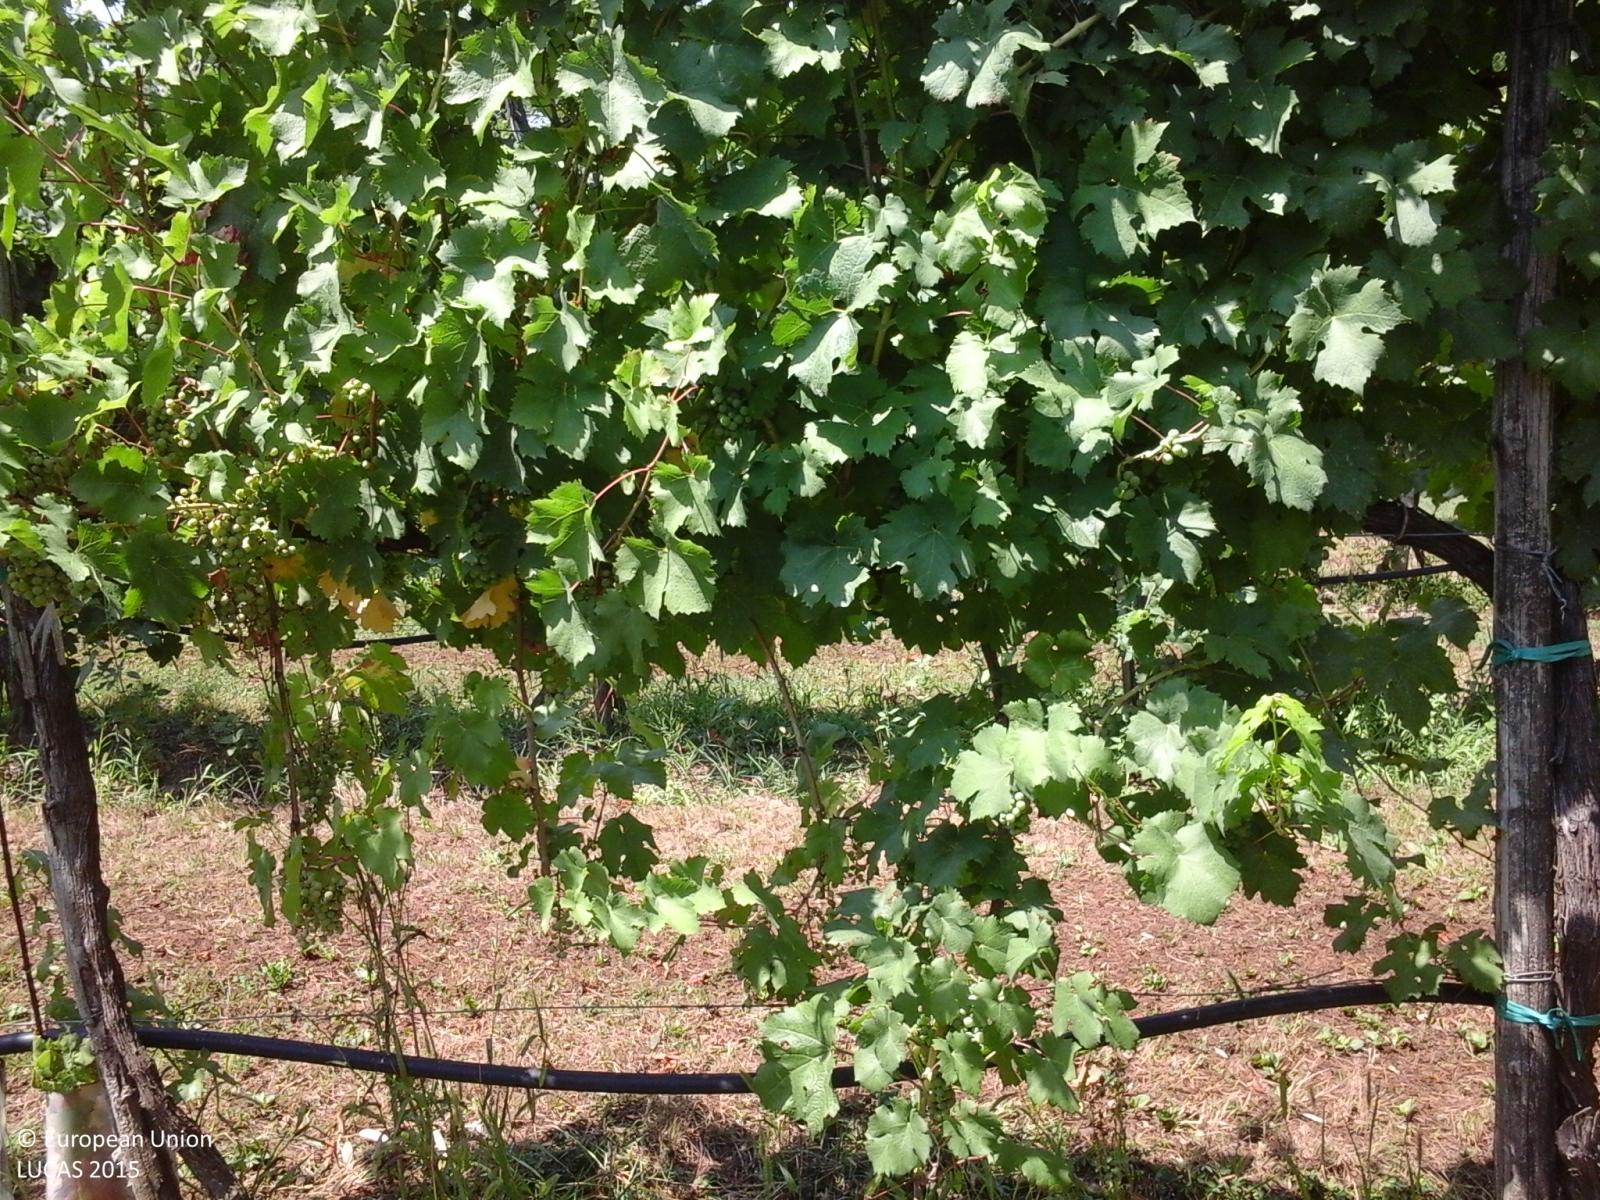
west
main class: Cropland
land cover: Vineyards
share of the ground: 50 - 75 %
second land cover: Grassland without tree/shrub cover
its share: > 75 %
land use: Agriculture (excluding fallow land and kitchen gardens)
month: June
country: IT
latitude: 45.7092
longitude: 12.5013
